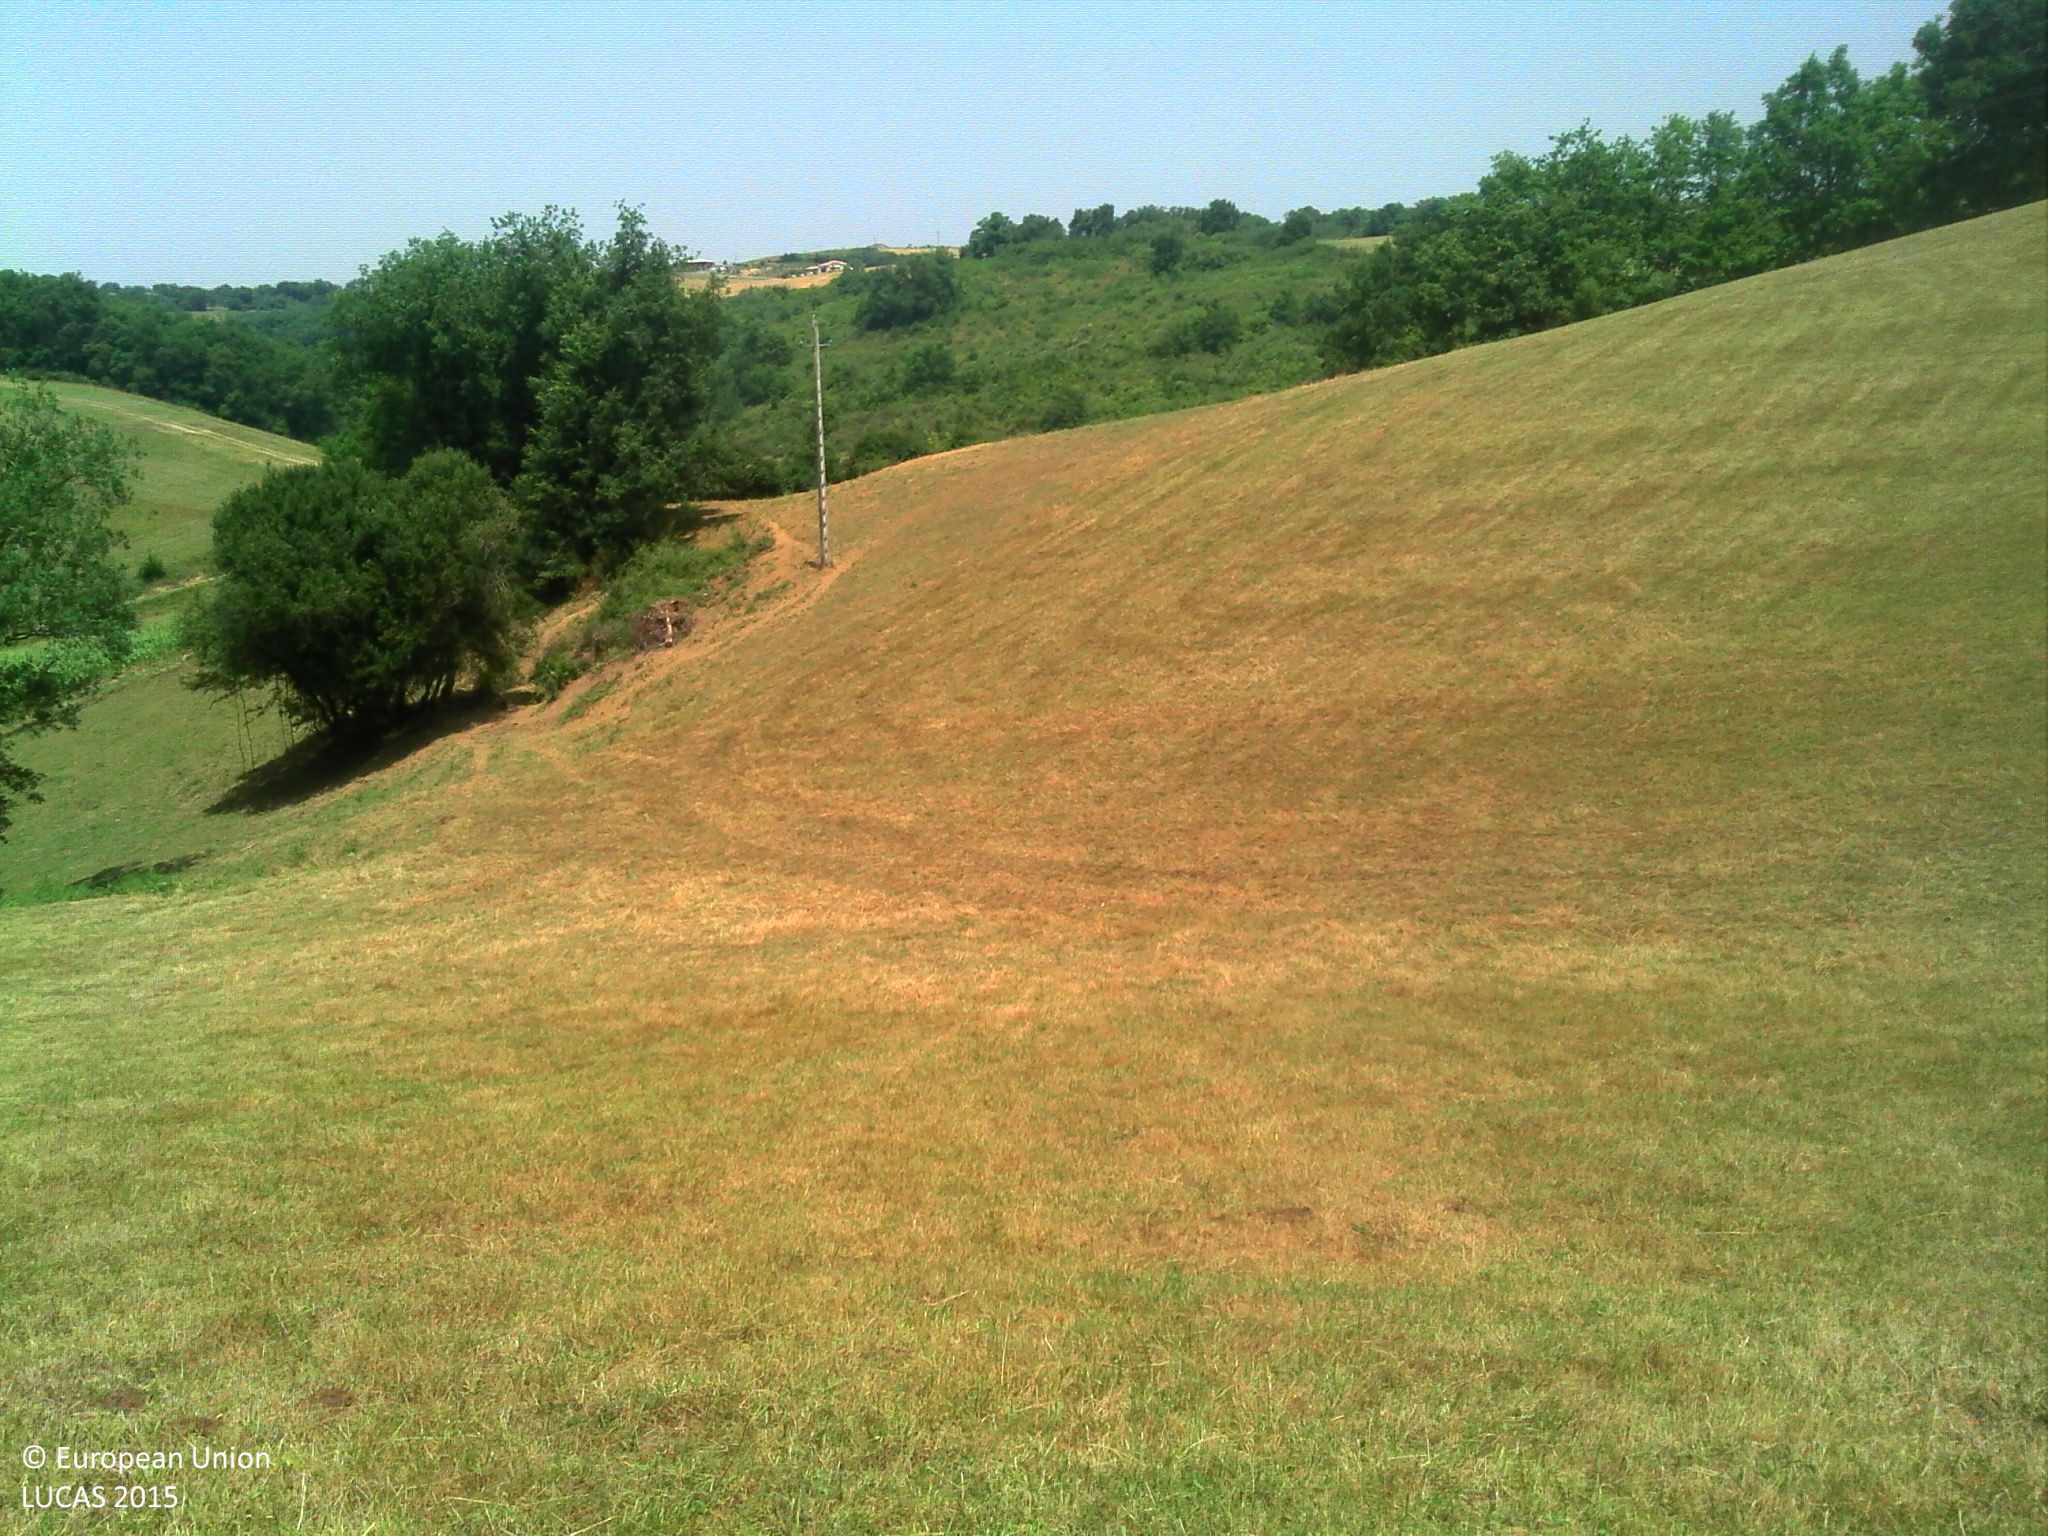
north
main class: Grassland
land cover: Grassland without tree/shrub cover
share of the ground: > 75 %
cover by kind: herbaceous plants 100 %
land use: Agriculture (excluding fallow land and kitchen gardens)
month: July
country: FR
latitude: 43.3275
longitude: 0.8381
